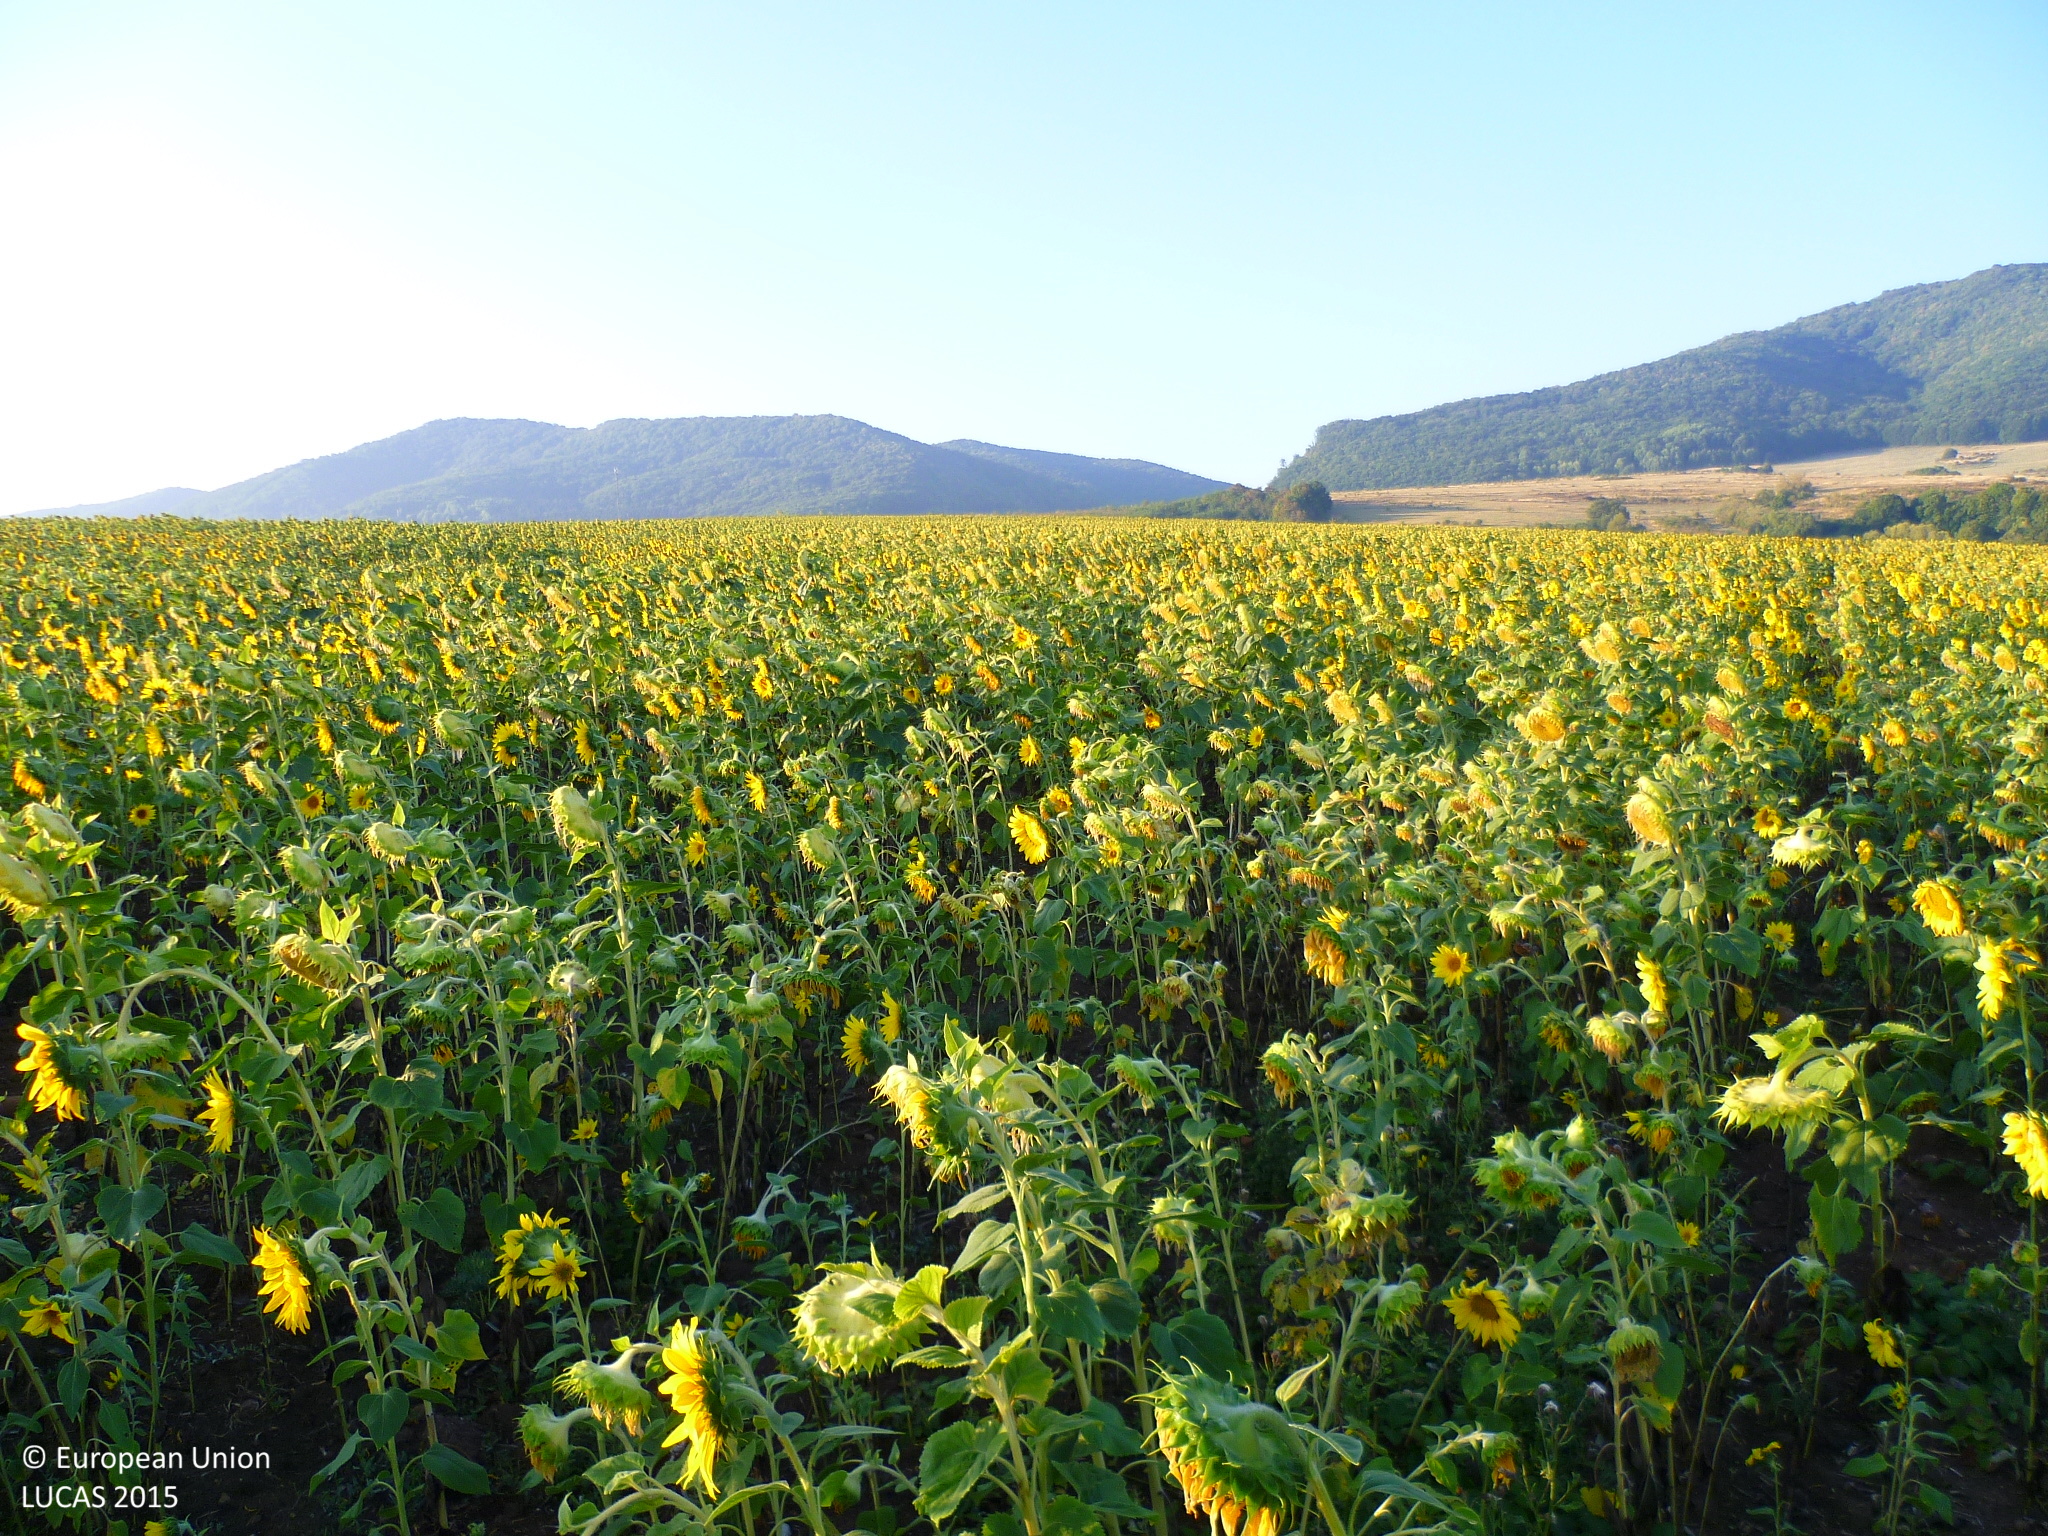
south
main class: Cropland
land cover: Sunflower
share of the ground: > 75 %
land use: Agriculture (excluding fallow land and kitchen gardens)
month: September
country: BG
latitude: 42.6875
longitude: 23.1522
